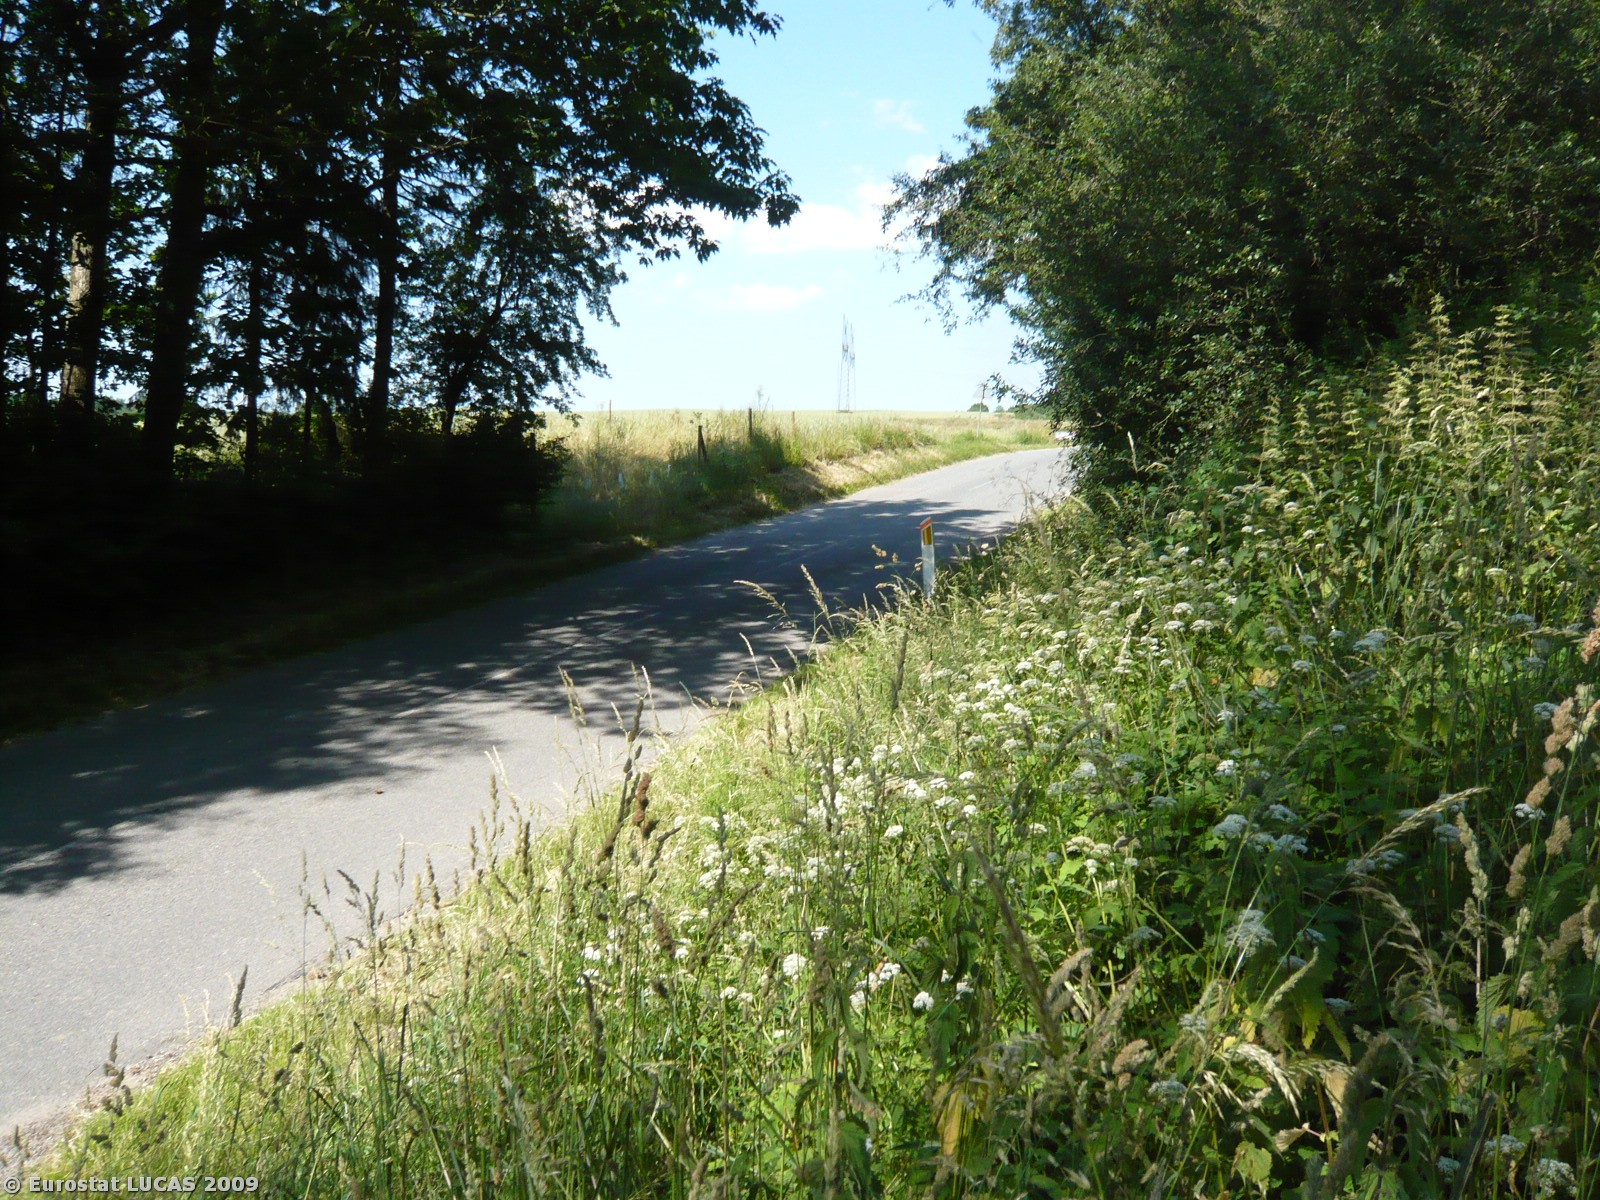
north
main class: Grassland
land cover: Spontaneously vegetated surfaces
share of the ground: > 75 %
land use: Fallow land
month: July
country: DK
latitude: 55.3788
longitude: 10.1734
